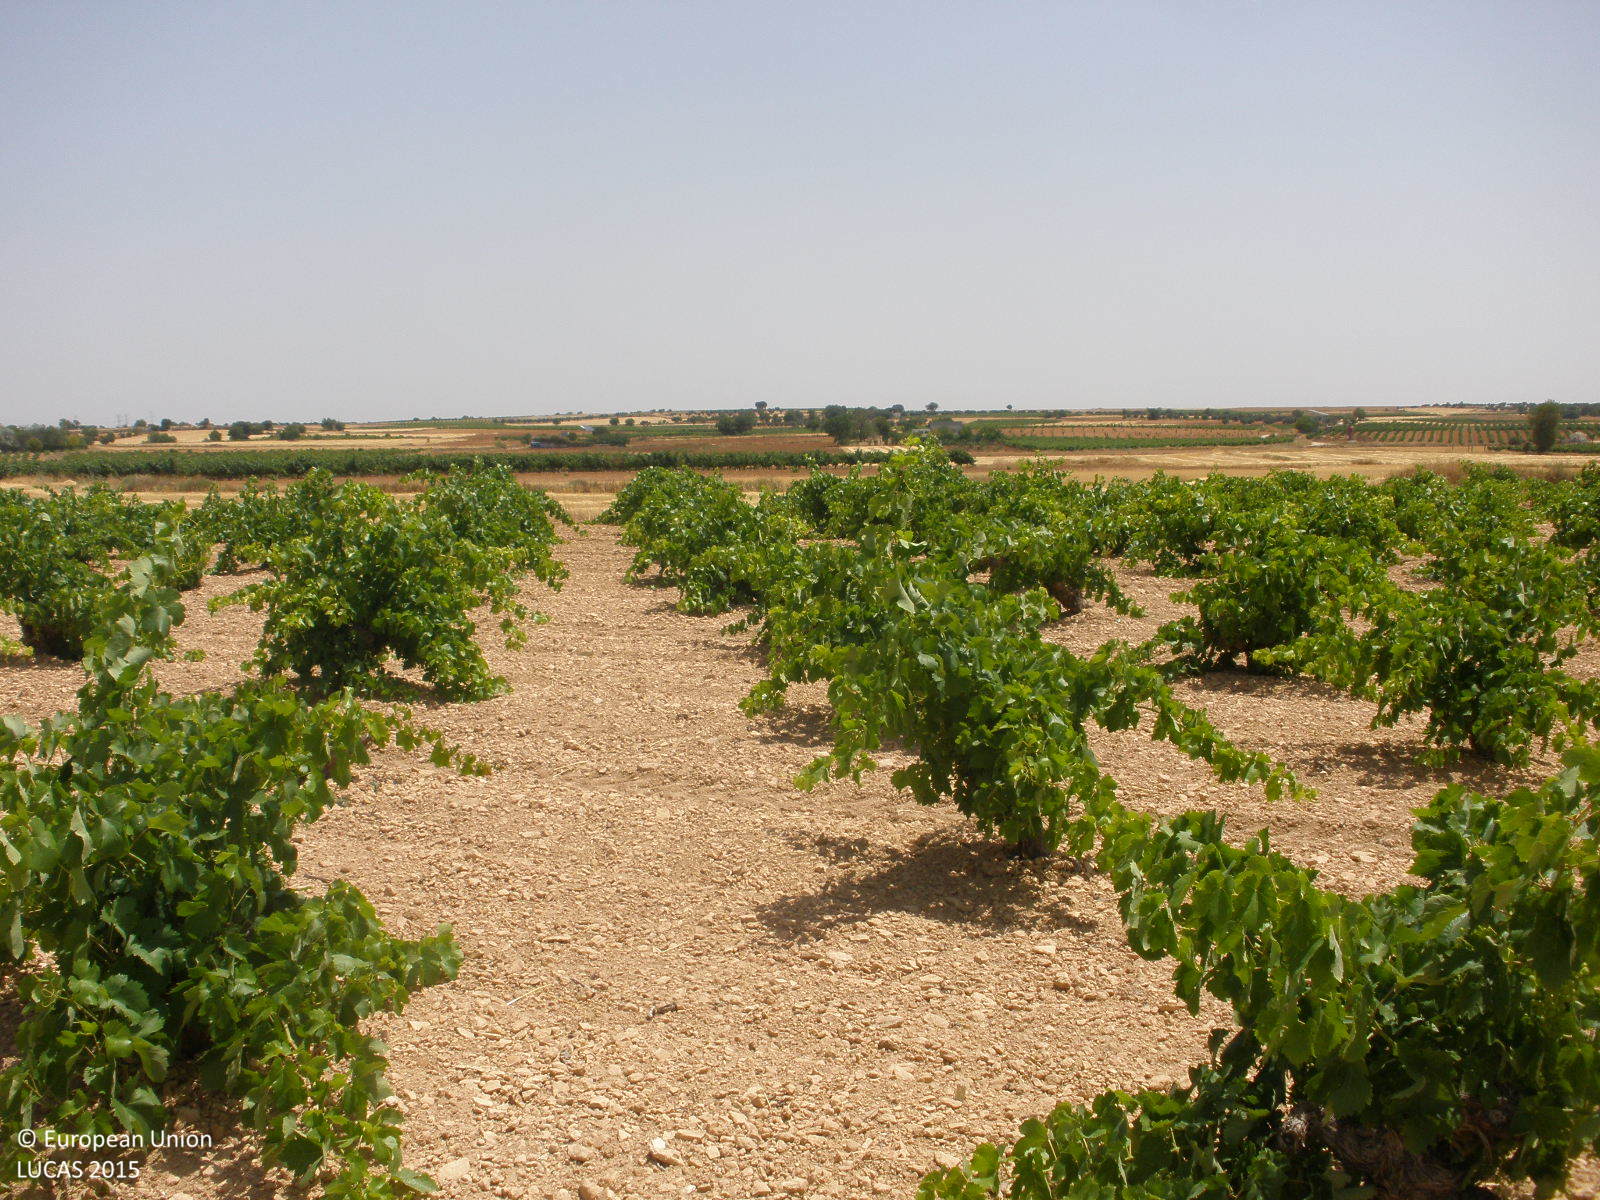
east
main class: Cropland
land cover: Vineyards
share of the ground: 50 - 75 %
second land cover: Other bare soil
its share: > 75 %
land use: Agriculture (excluding fallow land and kitchen gardens)
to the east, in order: Vineyards; Other bare soil; Grass margins; Barley; Grass margins; Barley; Other bare soil; Vineyards; Barley
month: July
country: ES
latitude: 39.9640
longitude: -3.1485
